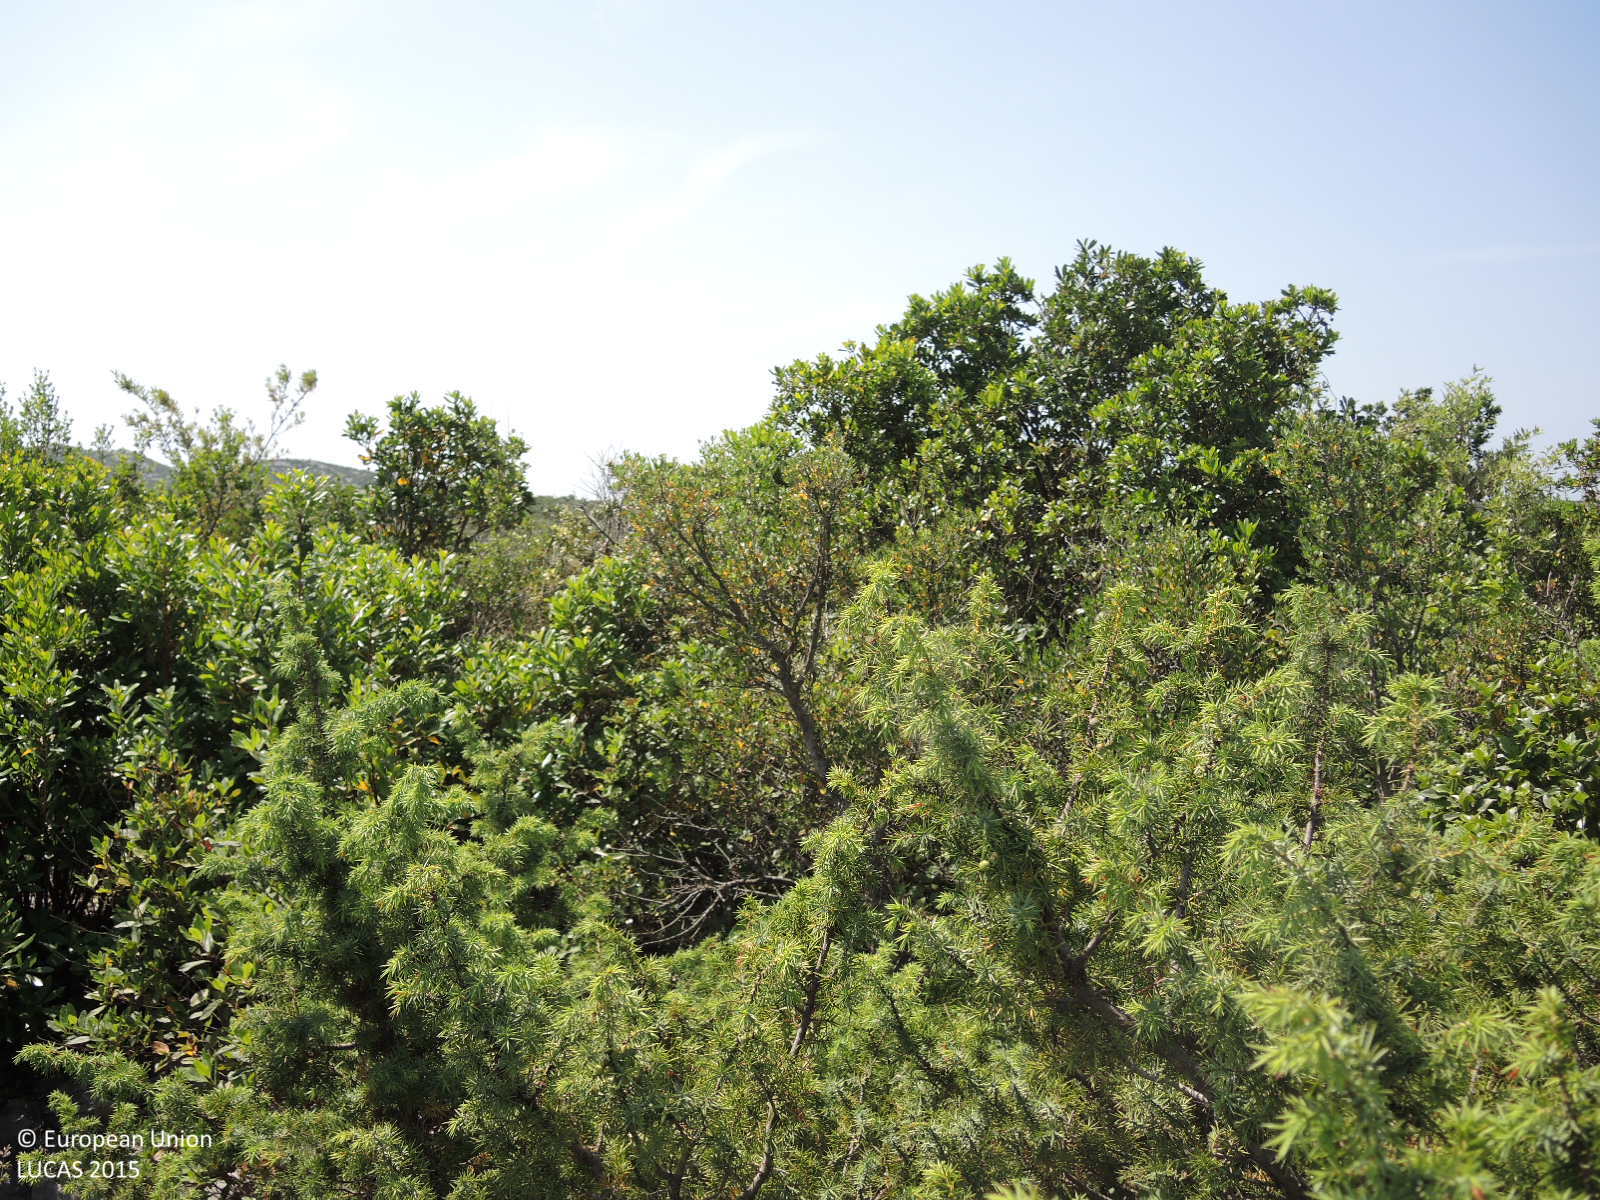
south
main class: Shrubland
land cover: Shrubland without tree cover
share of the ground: > 75 %
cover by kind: shrubs 70 %, herbaceous plants 20 %, unconsolidated bare surface 10 %
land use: Semi-natural and natural areas not in use
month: May
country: HR
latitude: 43.8503
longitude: 15.7011
